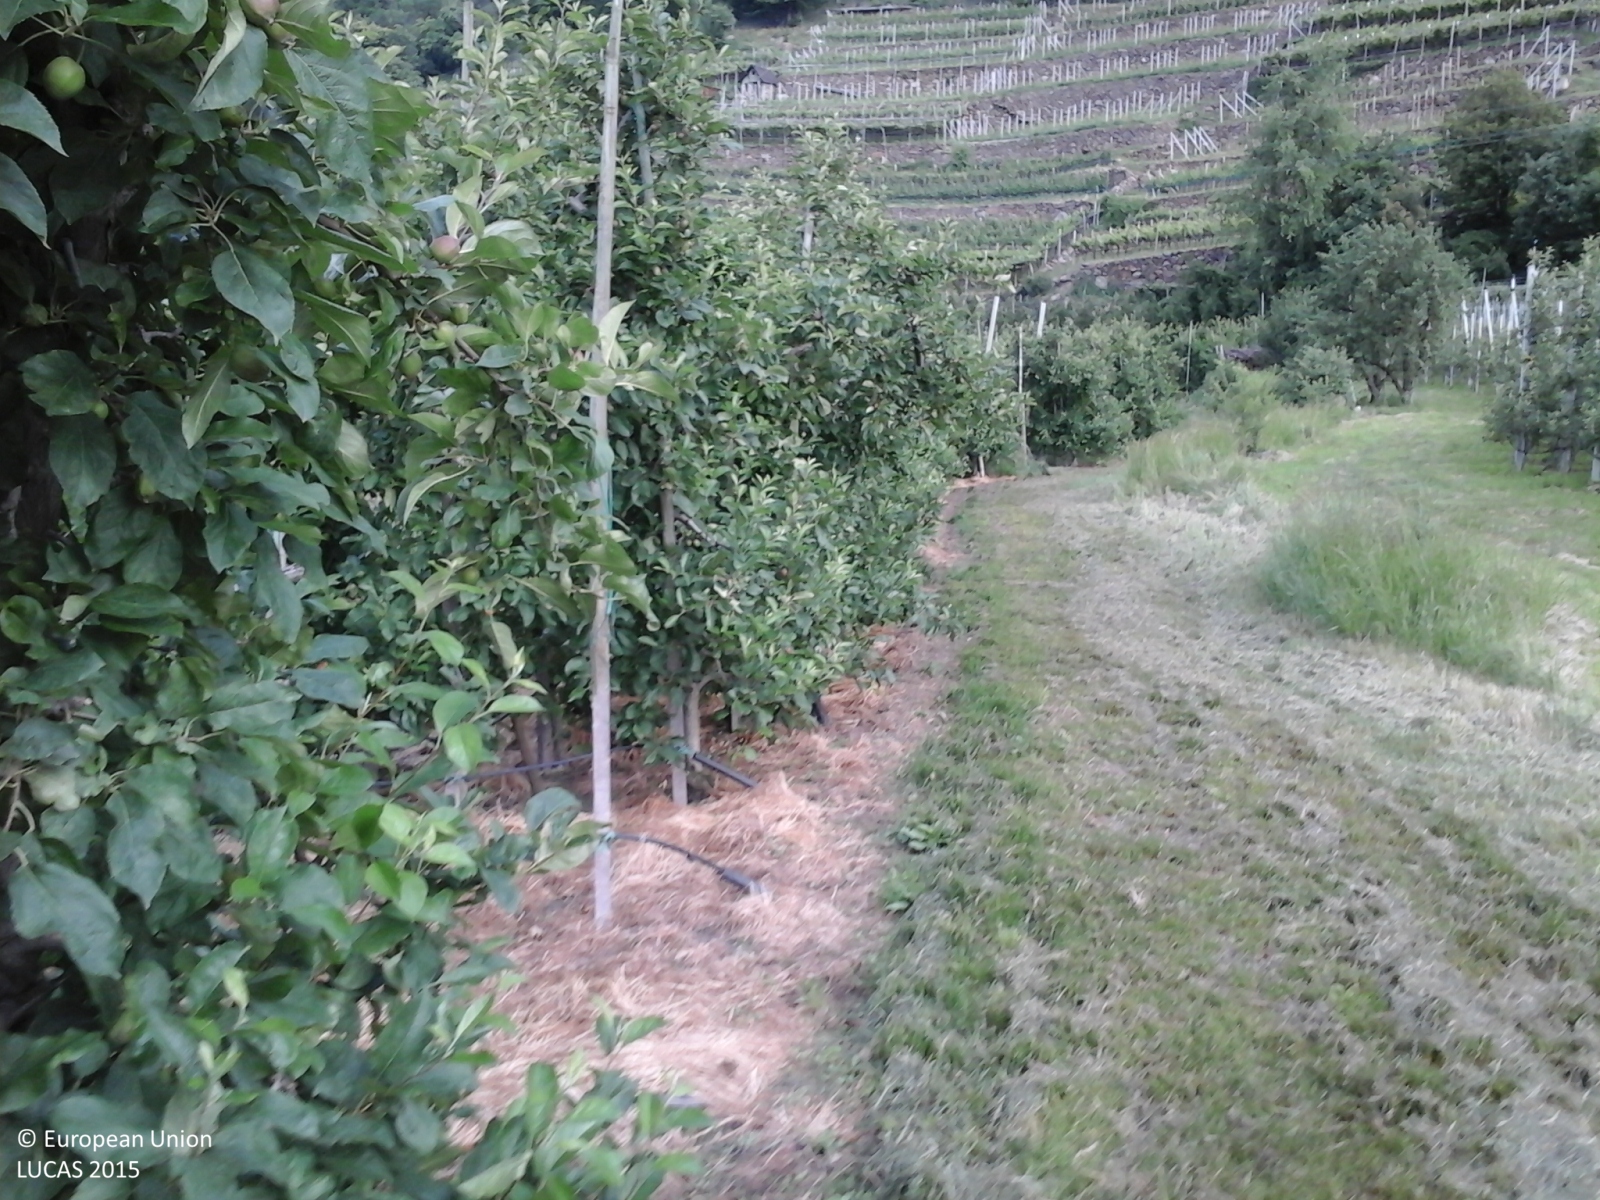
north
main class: Cropland
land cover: Apple fruit
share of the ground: > 75 %
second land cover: Grassland without tree/shrub cover
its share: > 75 %
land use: Agriculture (excluding fallow land and kitchen gardens)
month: June
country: IT
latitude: 46.6354
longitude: 10.9263
